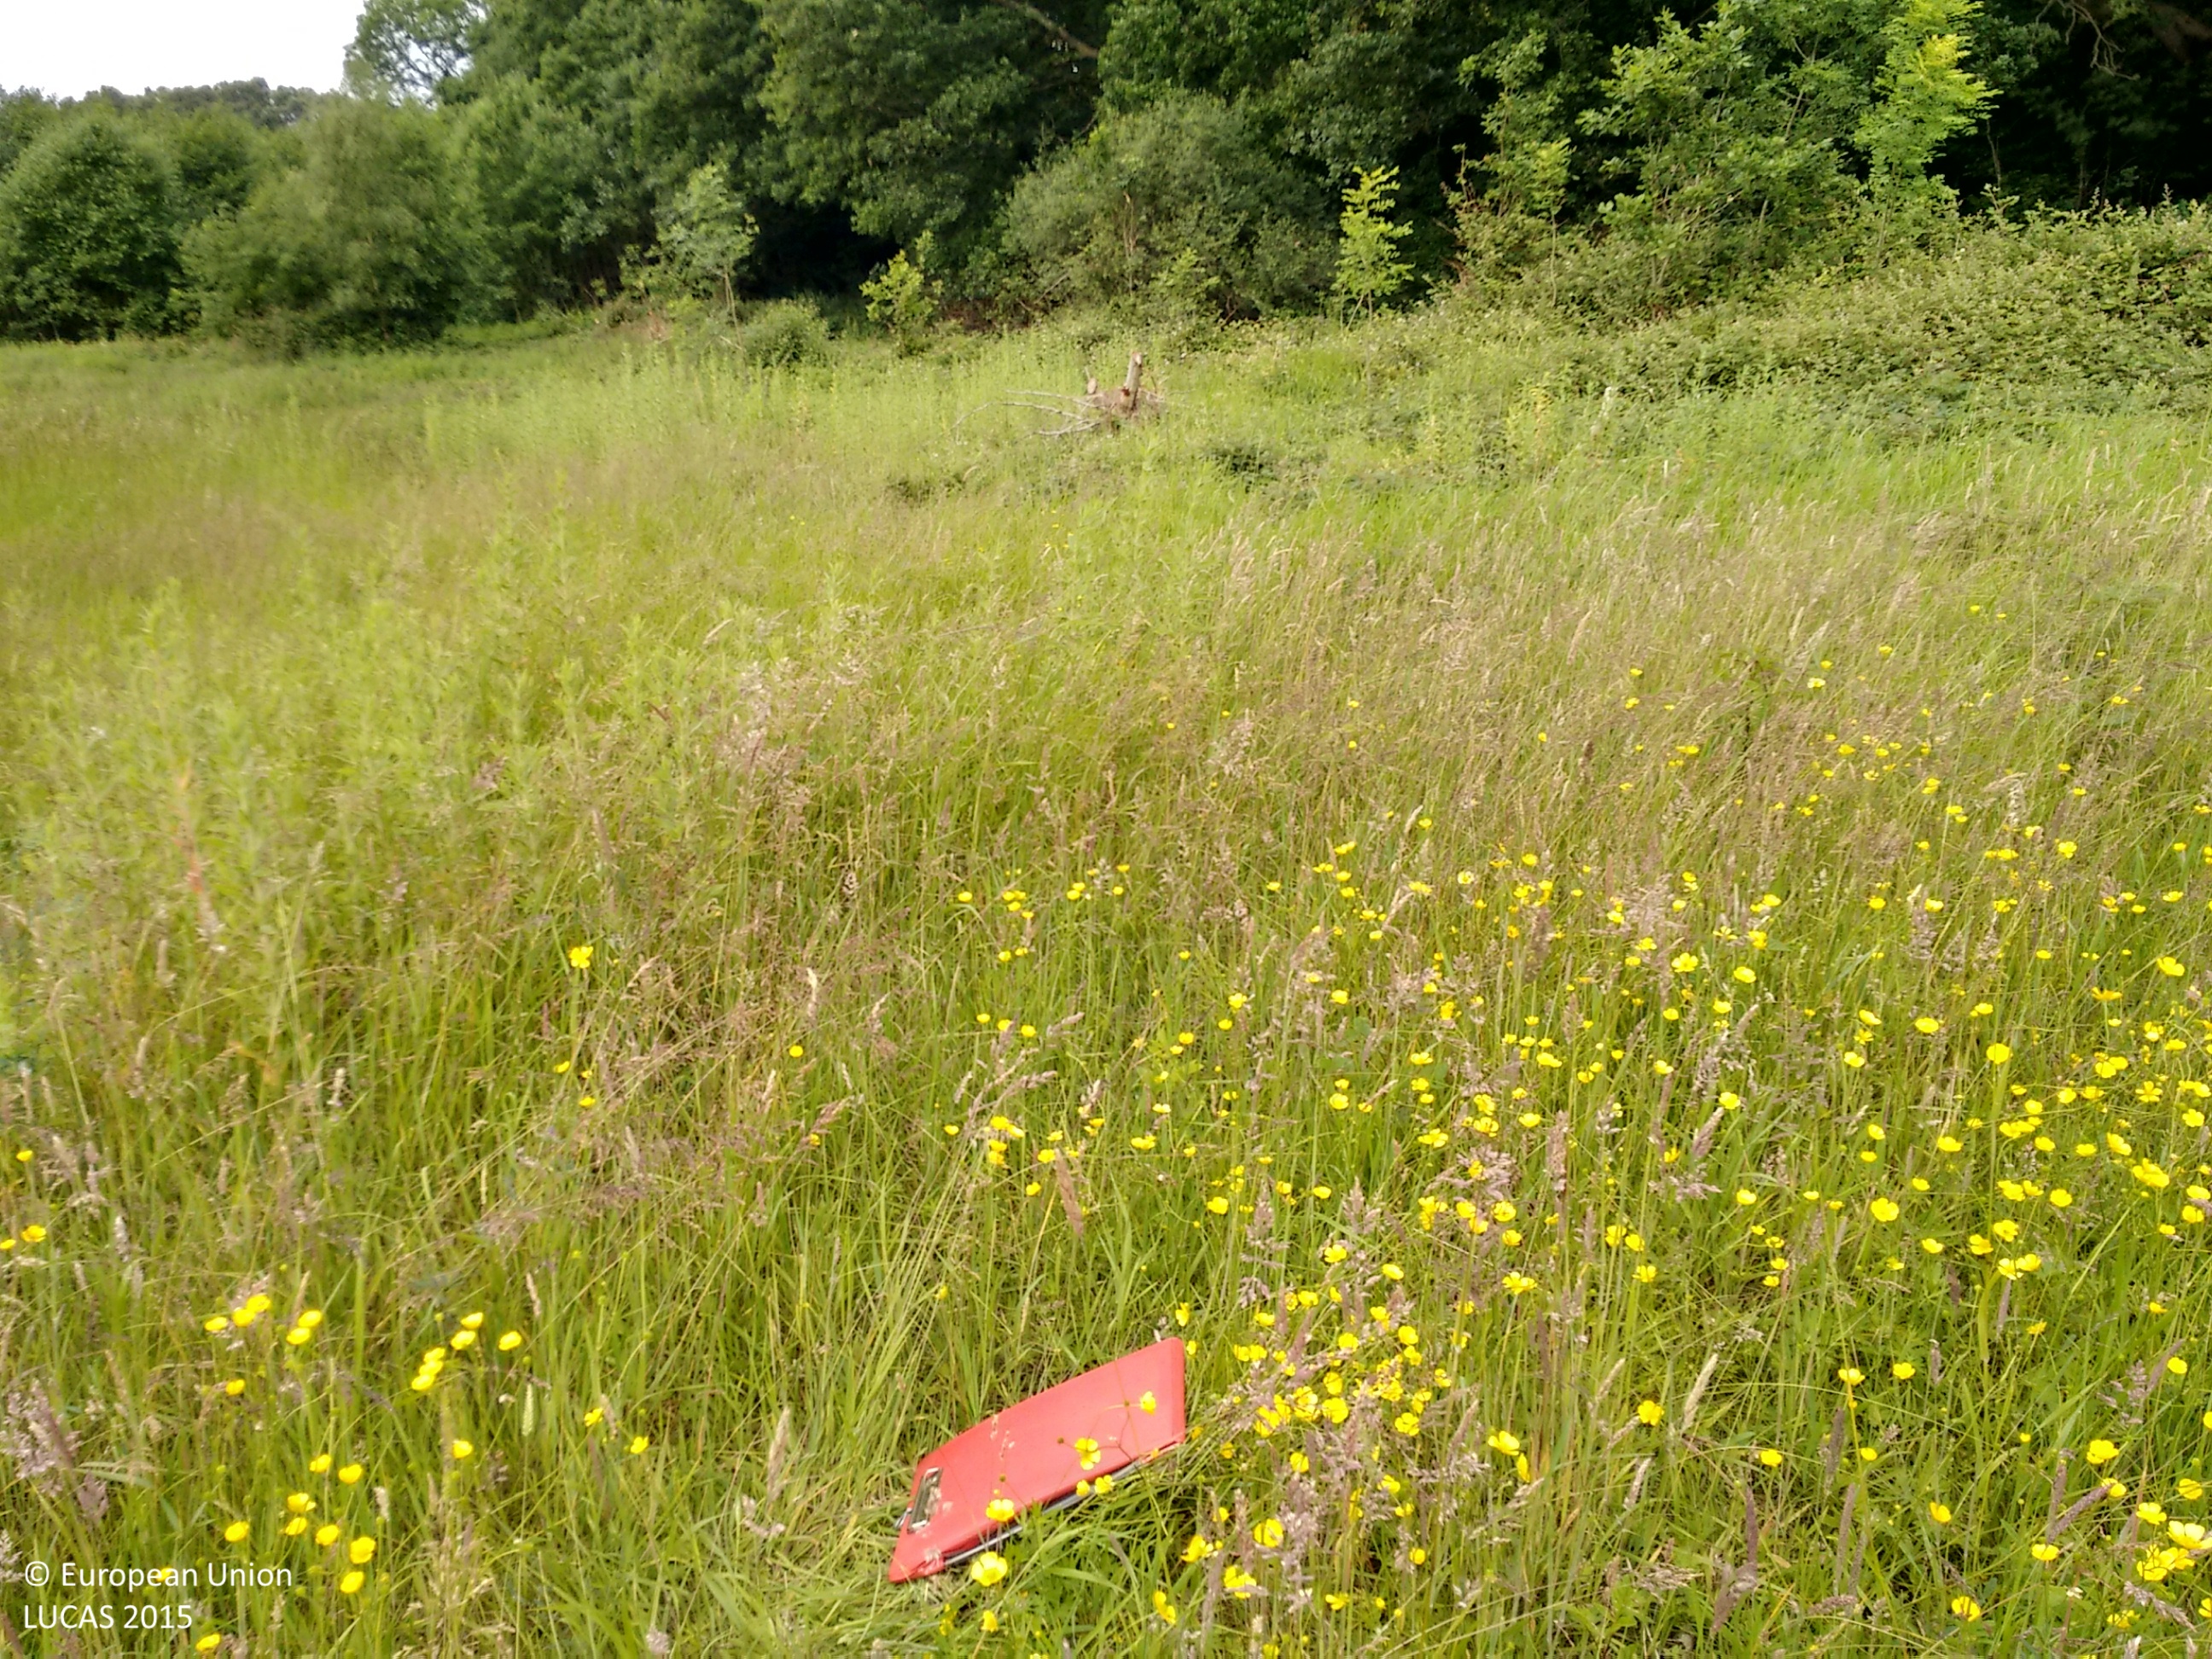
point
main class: Grassland
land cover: Grassland with sparse tree/shrub cover
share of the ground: > 75 %
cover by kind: herbaceous plants 85 %, shrubs 10 %, broadleaved forest trees 5 %
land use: Agriculture (excluding fallow land and kitchen gardens)
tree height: > 5 m
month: June
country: GB
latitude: 53.2940
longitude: -1.4365
